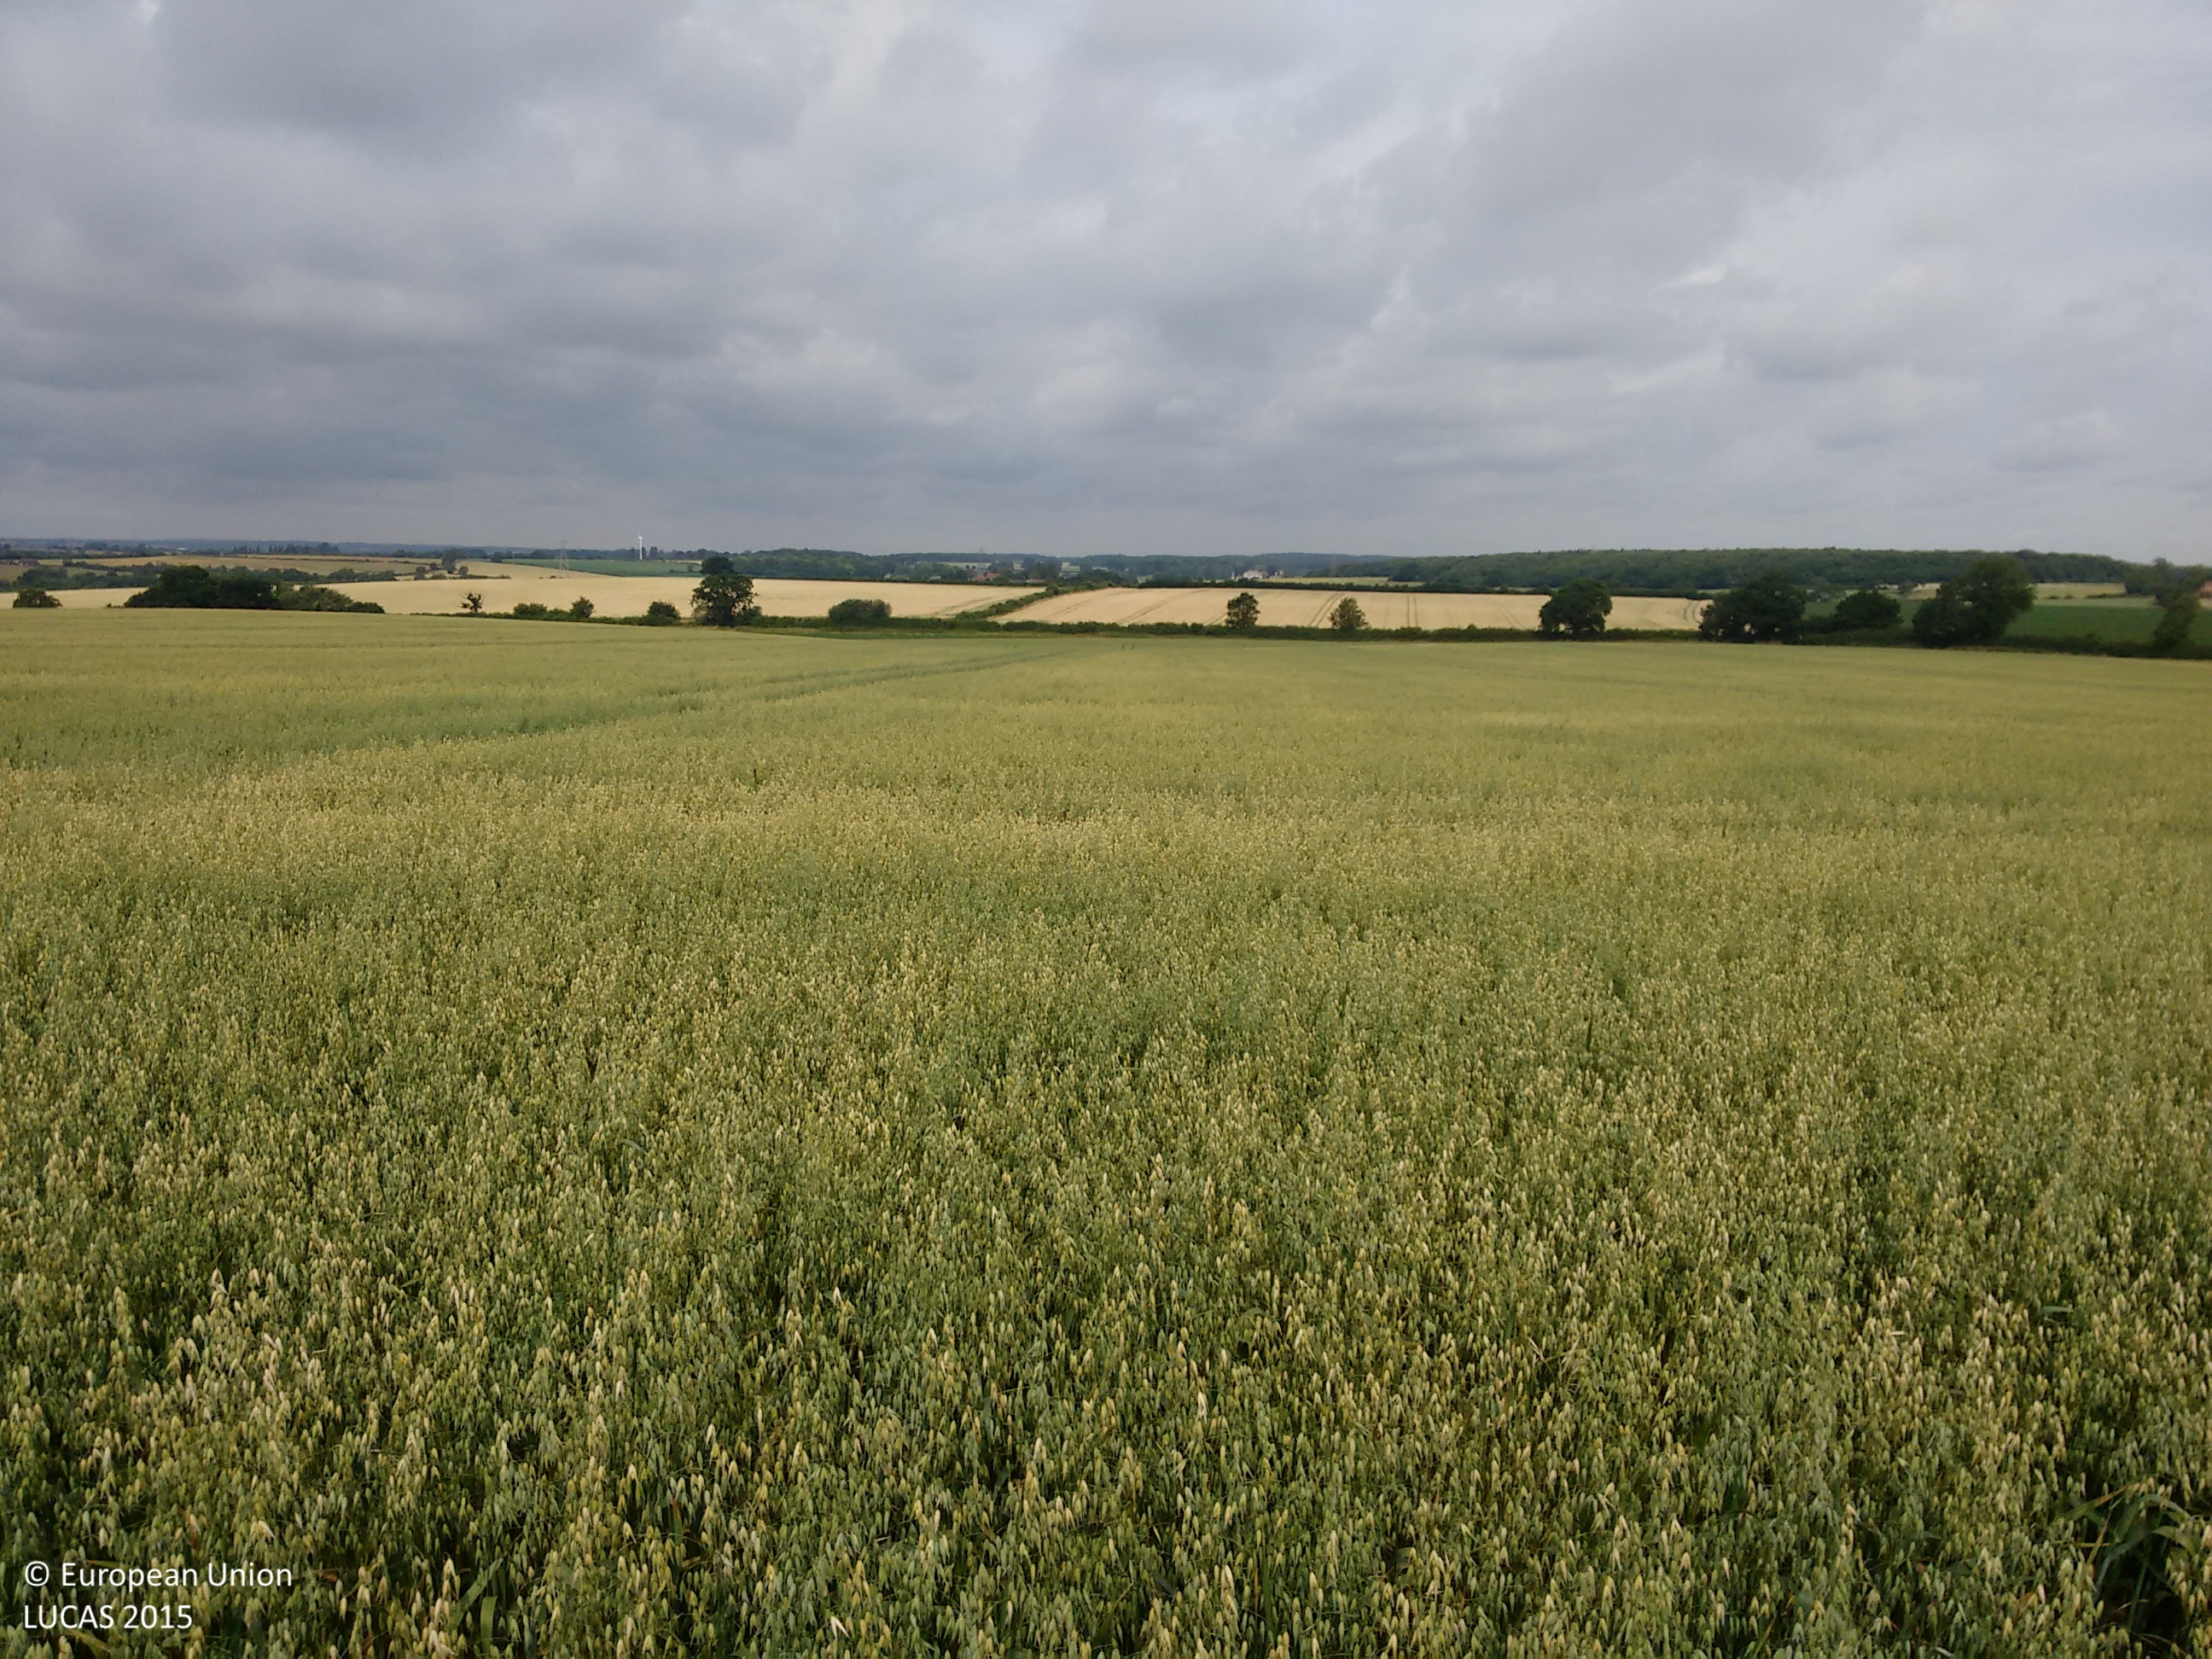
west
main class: Cropland
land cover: Oats
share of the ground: > 75 %
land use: Agriculture (excluding fallow land and kitchen gardens)
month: July
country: GB
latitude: 53.1077
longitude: -0.9023
